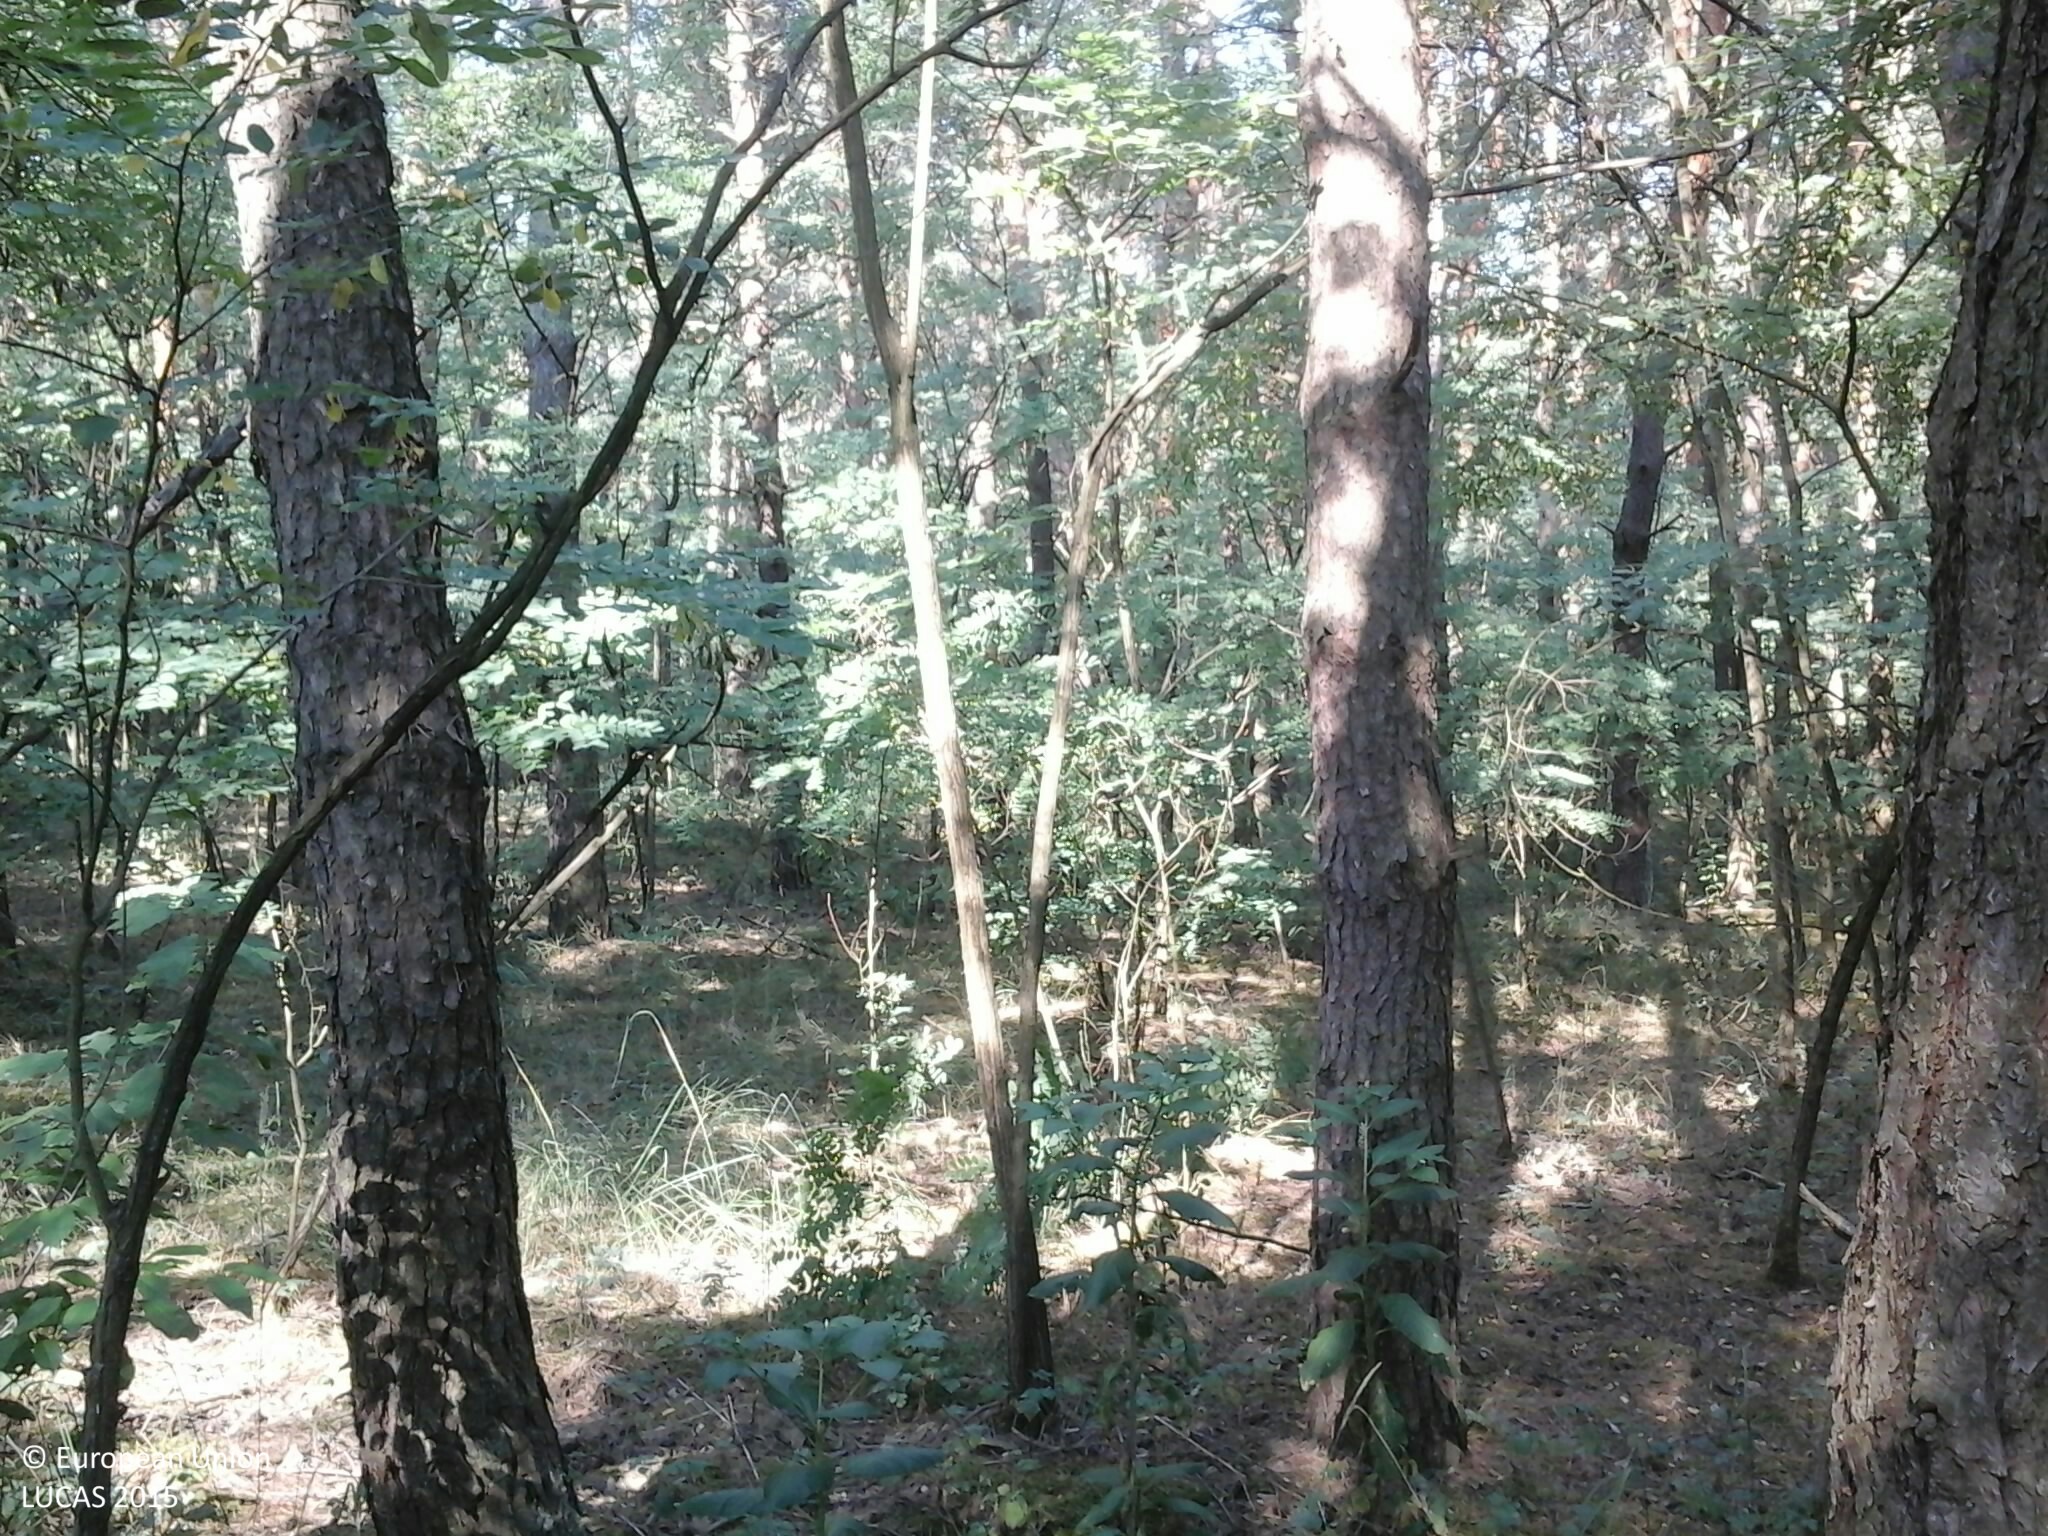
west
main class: Woodland
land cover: Pine dominated coniferous woodland
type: non-riverine alder, birch or aspen forest
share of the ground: 50 - 75 %
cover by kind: coniferous forest trees 75 %, broadleaved forest trees 20 %, herbaceous plants 5 %
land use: Forestry
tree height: > 5 m
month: July
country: HU
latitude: 47.9139
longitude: 21.9732
